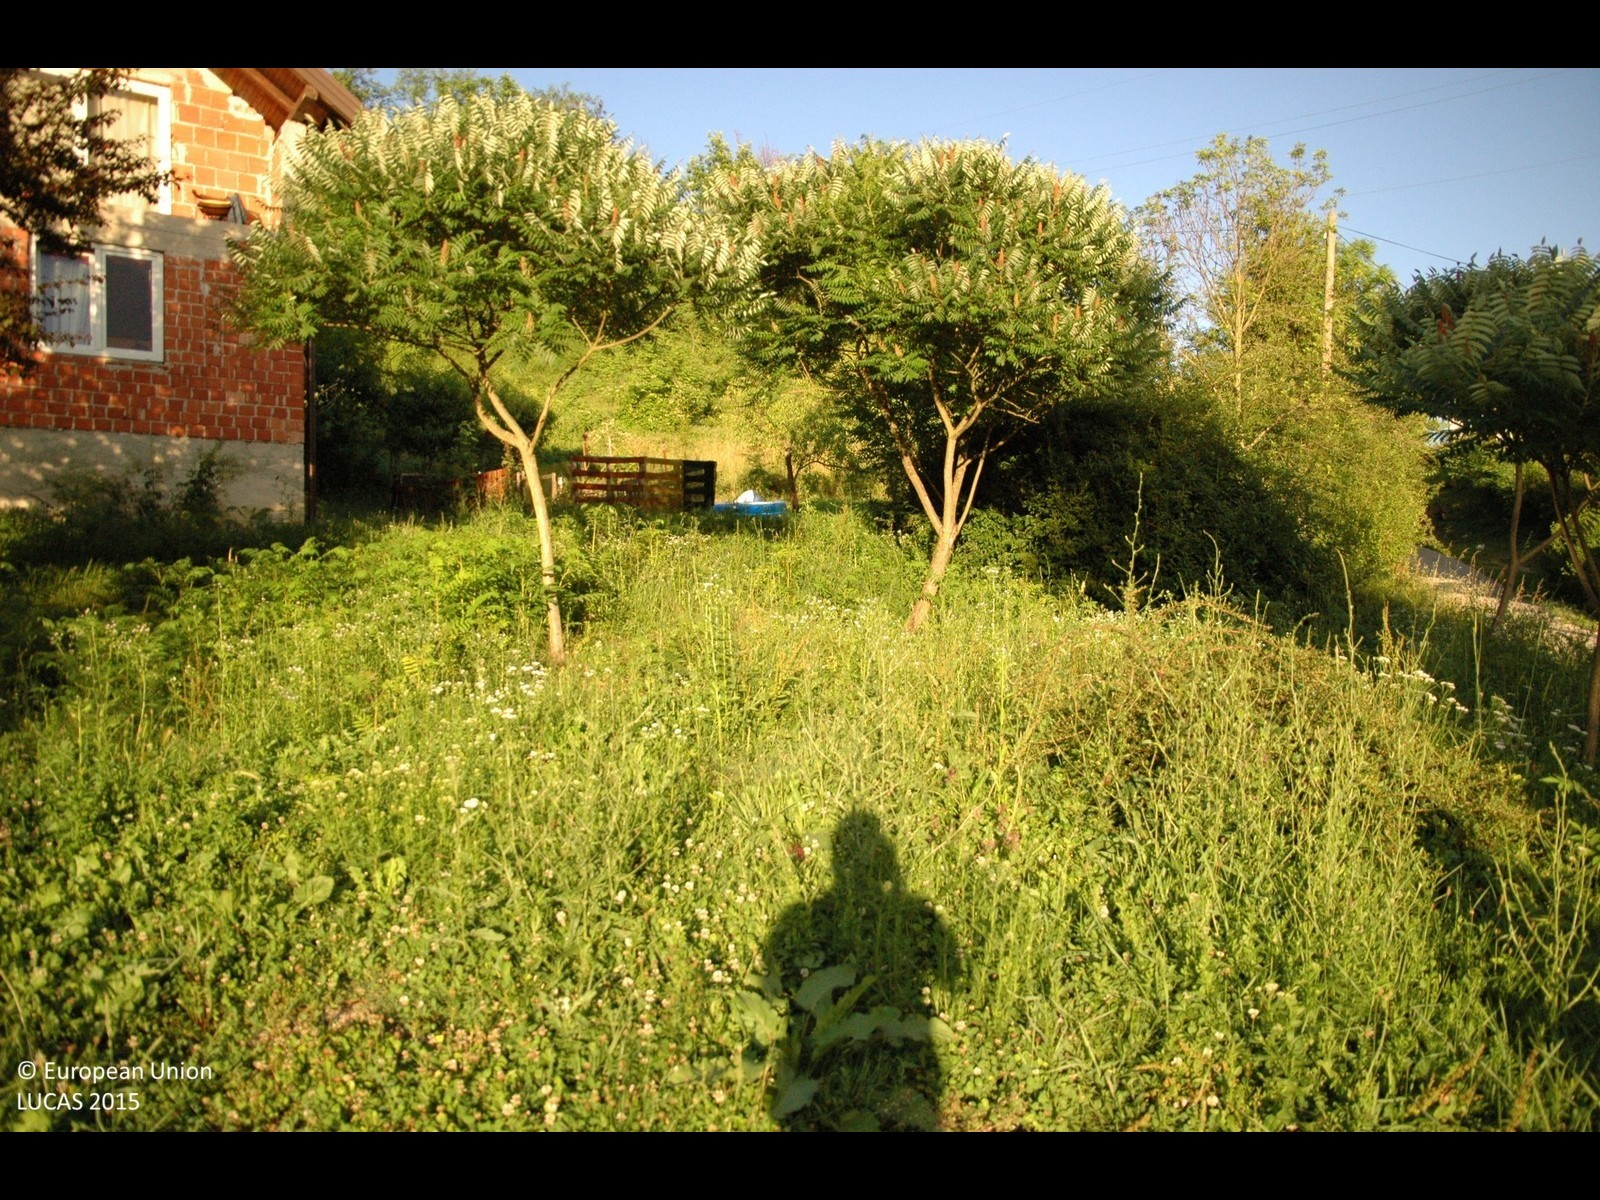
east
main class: Grassland
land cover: Grassland with sparse tree/shrub cover
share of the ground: > 75 %
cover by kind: herbaceous plants 95 %, broadleaved forest trees 5 %
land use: Residential
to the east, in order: Grassland with sparse tree/shrub cover; Artificial constructions in urban areas; Grassland without tree/shrub cover; Shrubland without tree cover; Grassland without tree/shrub cover; Grassland with sparse tree/shrub cover; Paved roads, cycling and walking lanes; Grass margins; Spontaneously vegetated surfaces; Paved roads, cycling and walking lanes; Grassland without tree/shrub cover; Artificial constructions in urban areas
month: June
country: HR
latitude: 46.0687
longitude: 15.7772
